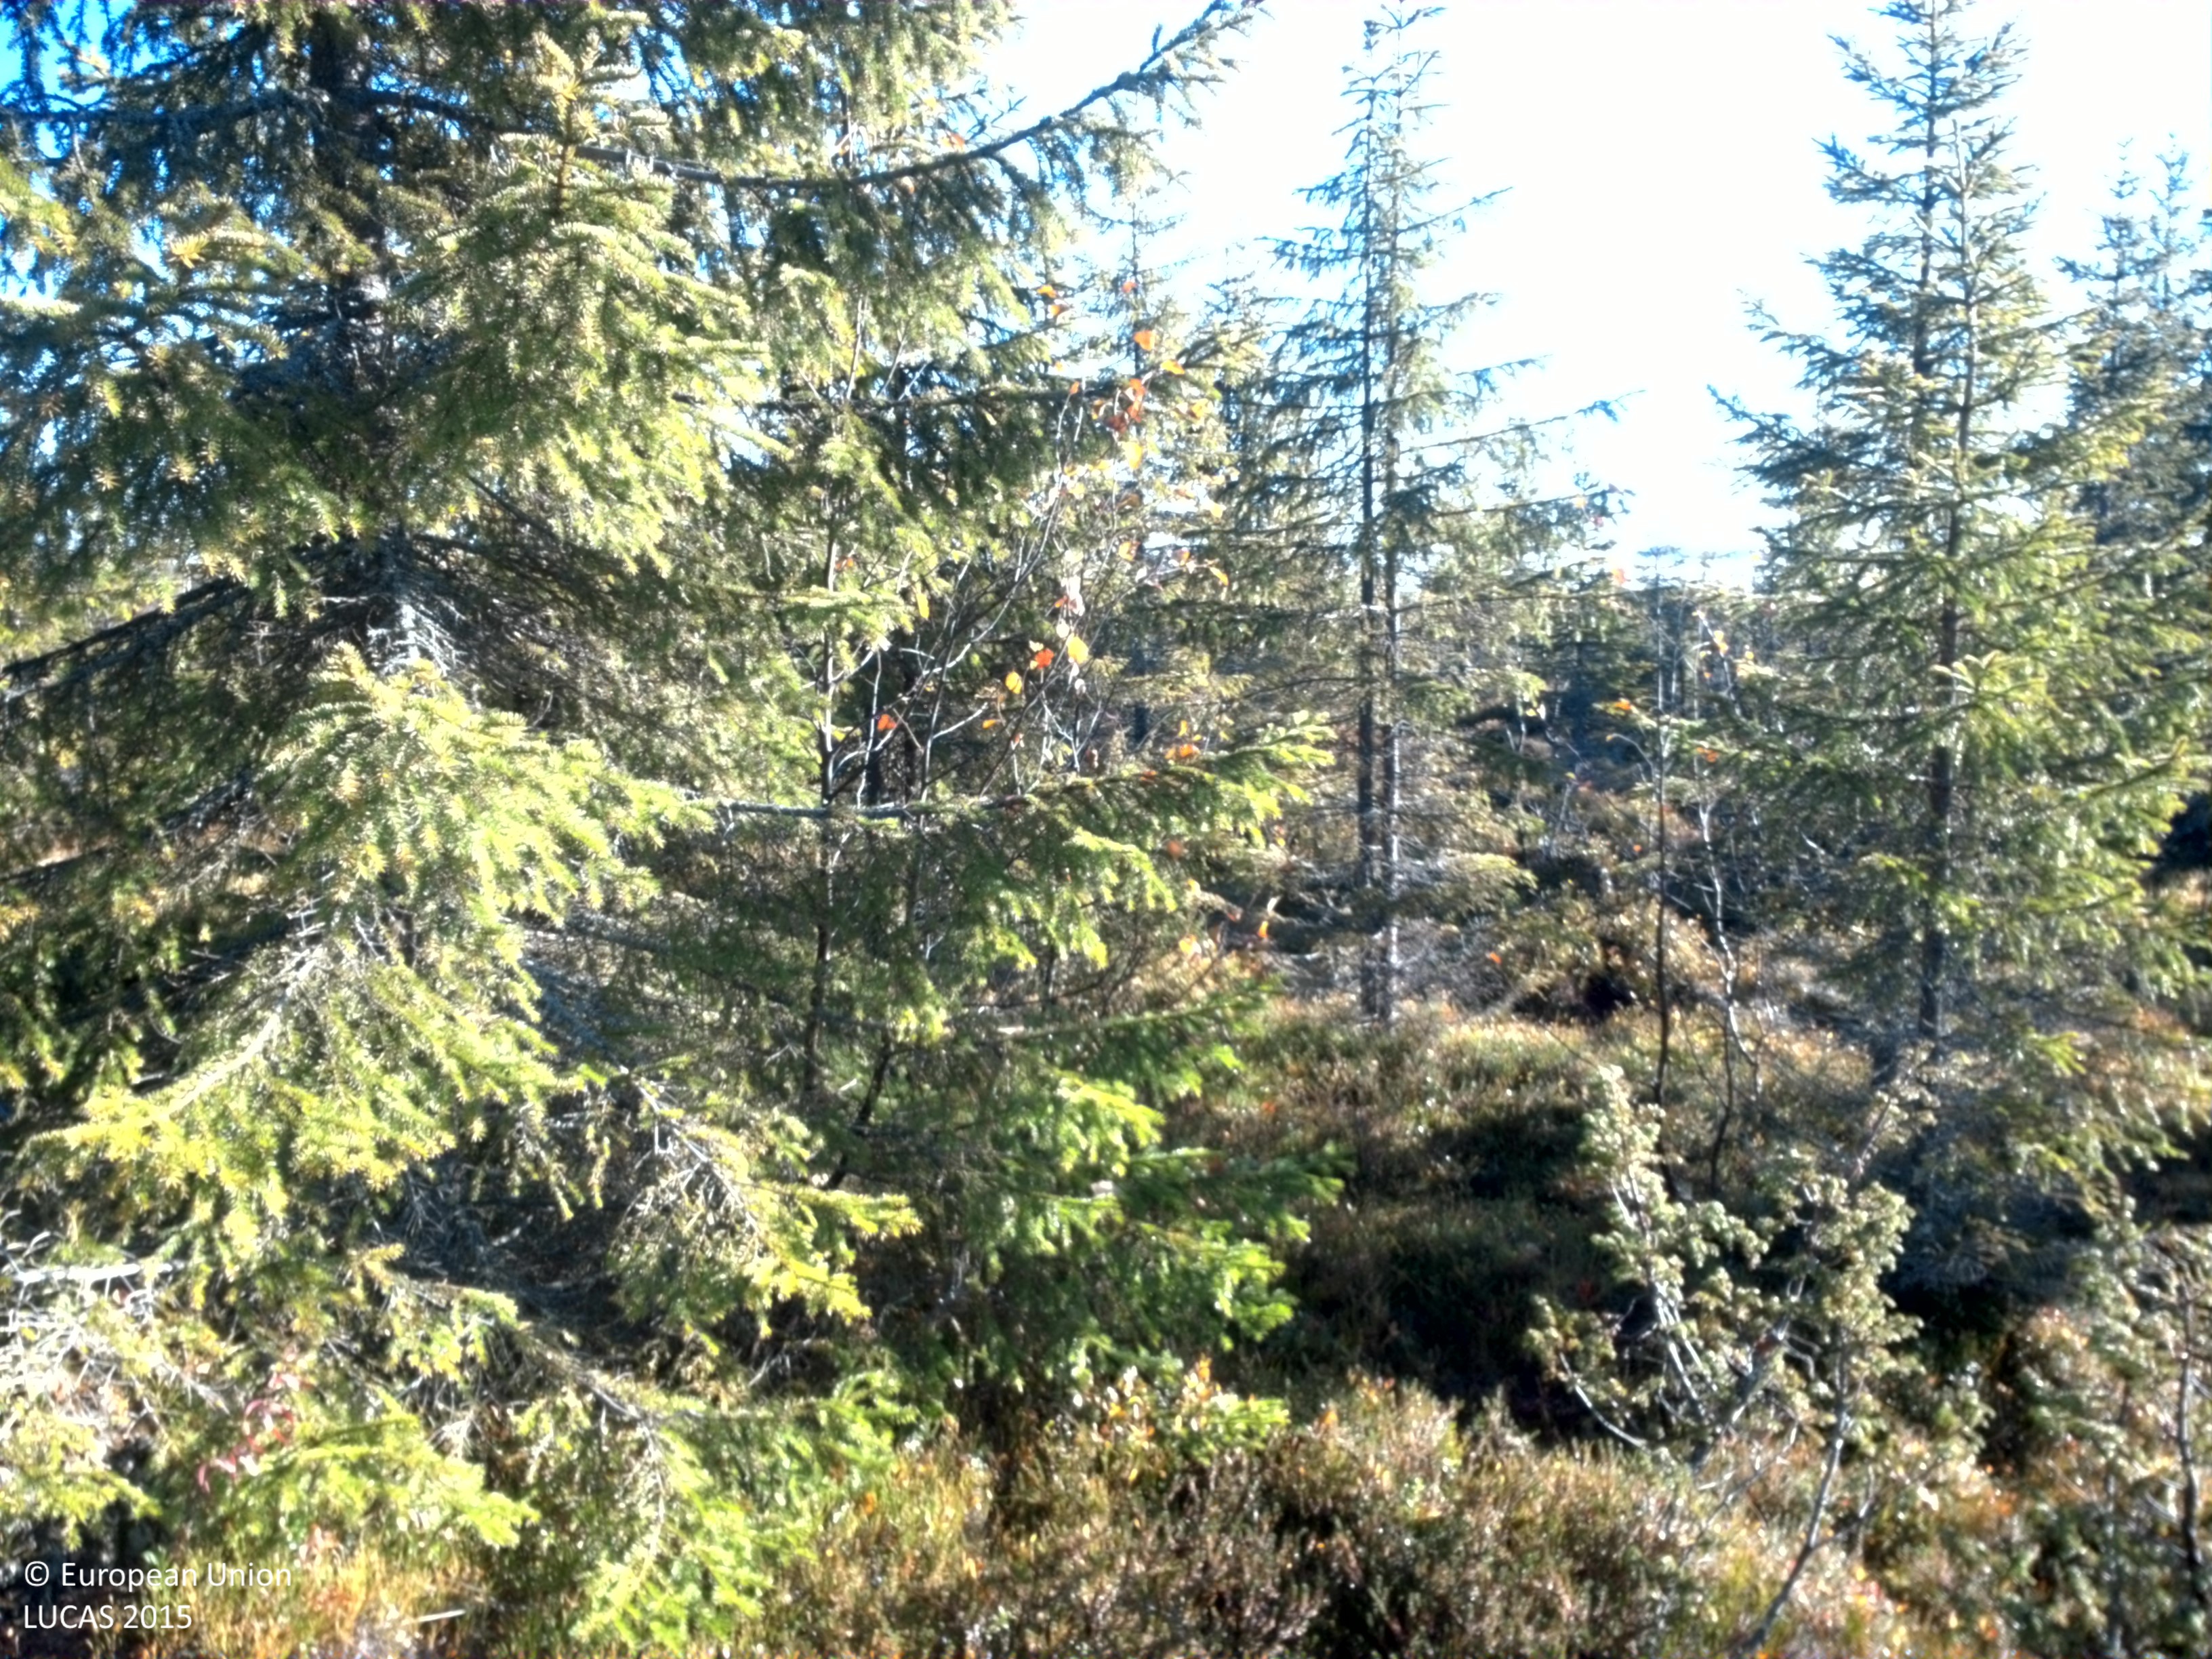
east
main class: Woodland
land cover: Spruce dominated coniferous woodland
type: boreal forest
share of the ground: 10 - 25 %
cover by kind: shrubs 65 %, coniferous forest trees 15 %, herbaceous plants 10 %, lichens and mosses 10 %
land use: Forestry
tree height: < 5 m
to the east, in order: Spruce dominated coniferous woodland; Spruce dominated mixed woodland
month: October
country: SE
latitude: 64.8645
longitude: 16.9068
